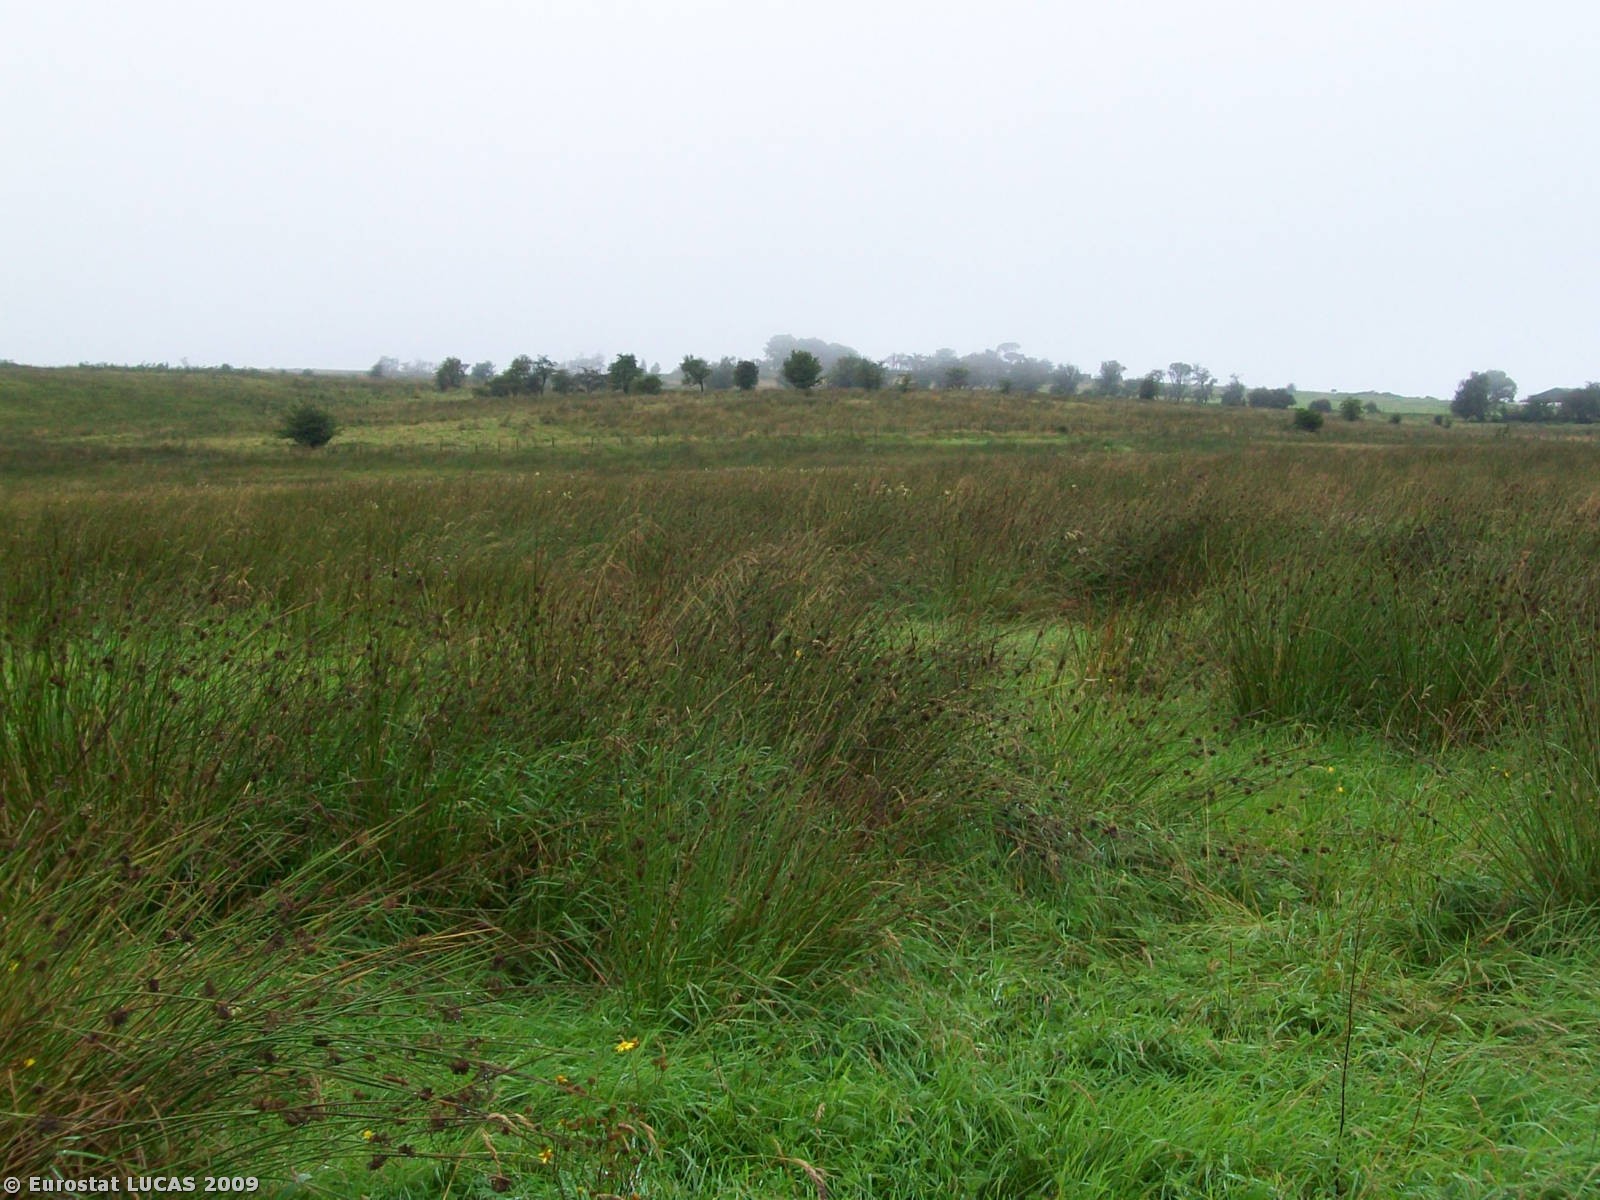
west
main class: Grassland
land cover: Grassland without tree/shrub cover
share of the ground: > 75 %
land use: Agriculture (excluding fallow land and kitchen gardens)
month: August
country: GB
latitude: 54.5780
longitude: -6.0619
